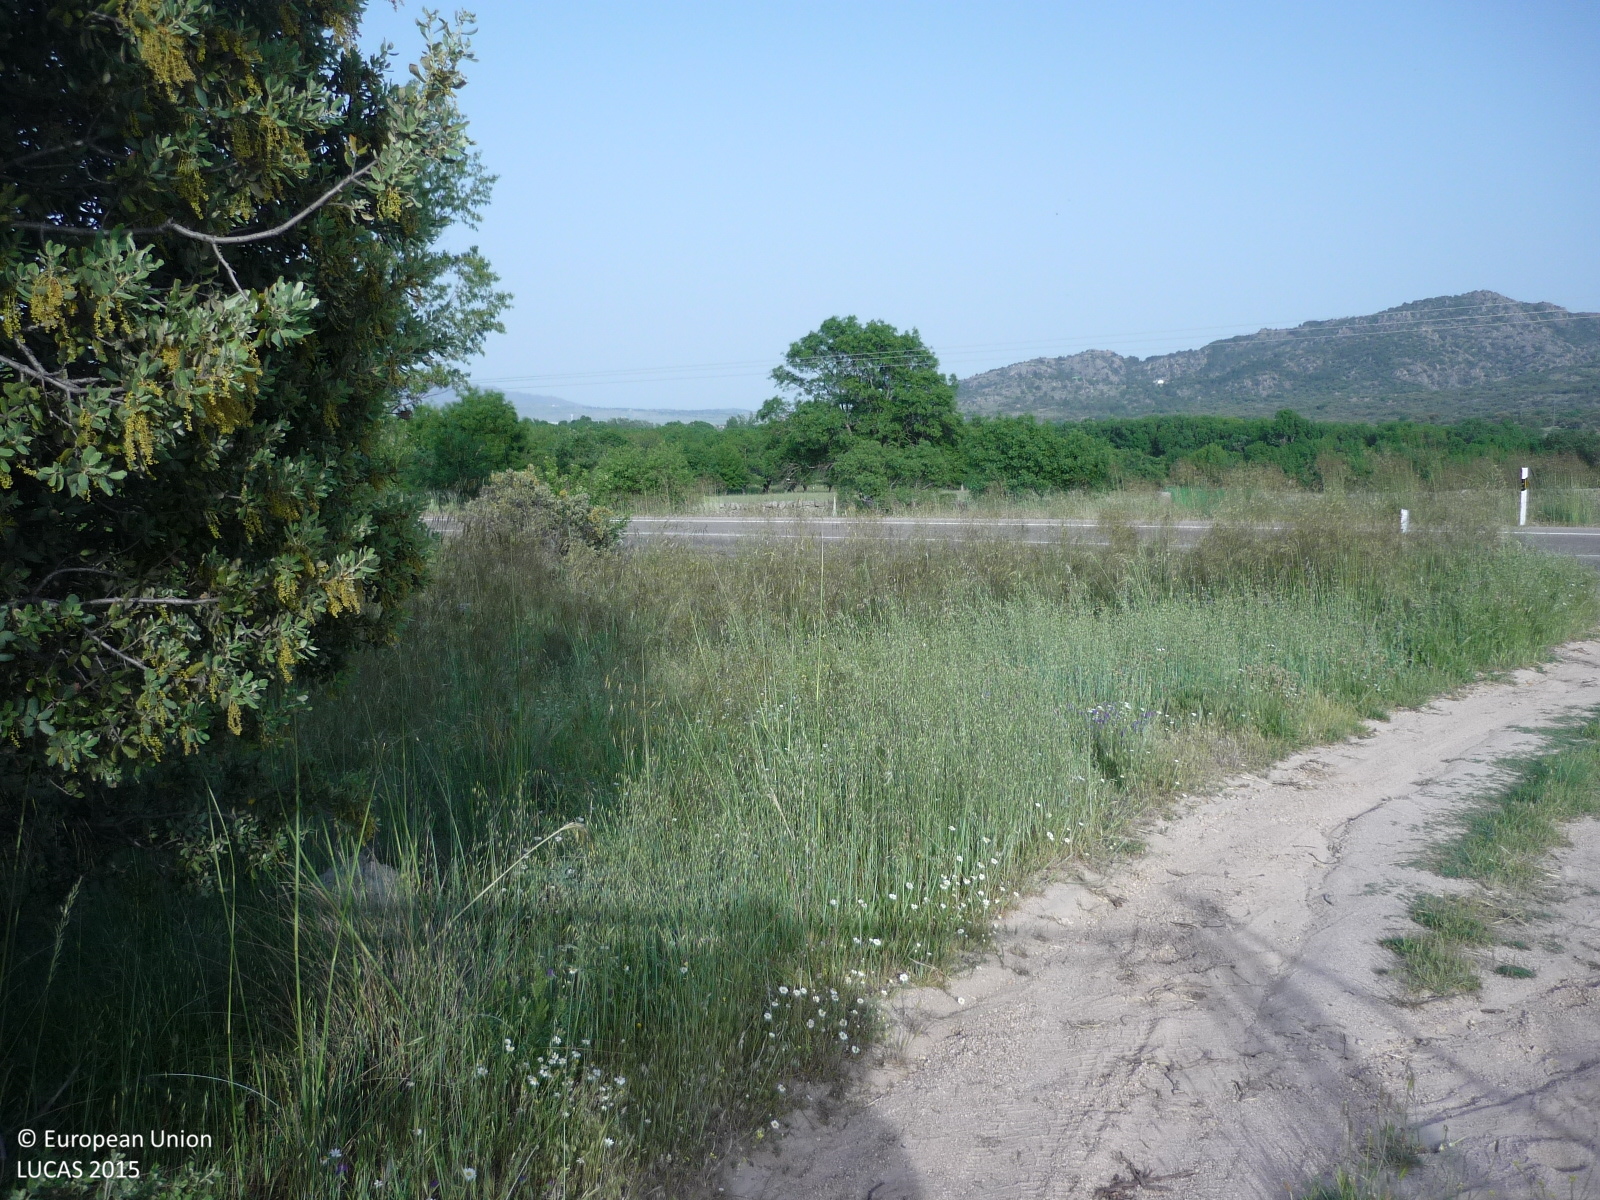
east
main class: Grassland
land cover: Grassland with sparse tree/shrub cover
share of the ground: > 75 %
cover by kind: herbaceous plants 85 %, shrubs 10 %, broadleaved forest trees 5 %
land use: Agriculture (excluding fallow land and kitchen gardens)
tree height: < 5 m
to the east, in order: Grassland with sparse tree/shrub cover; Broadleaved woodland; Grassland with sparse tree/shrub cover
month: May
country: ES
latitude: 40.7224
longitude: -3.8837
